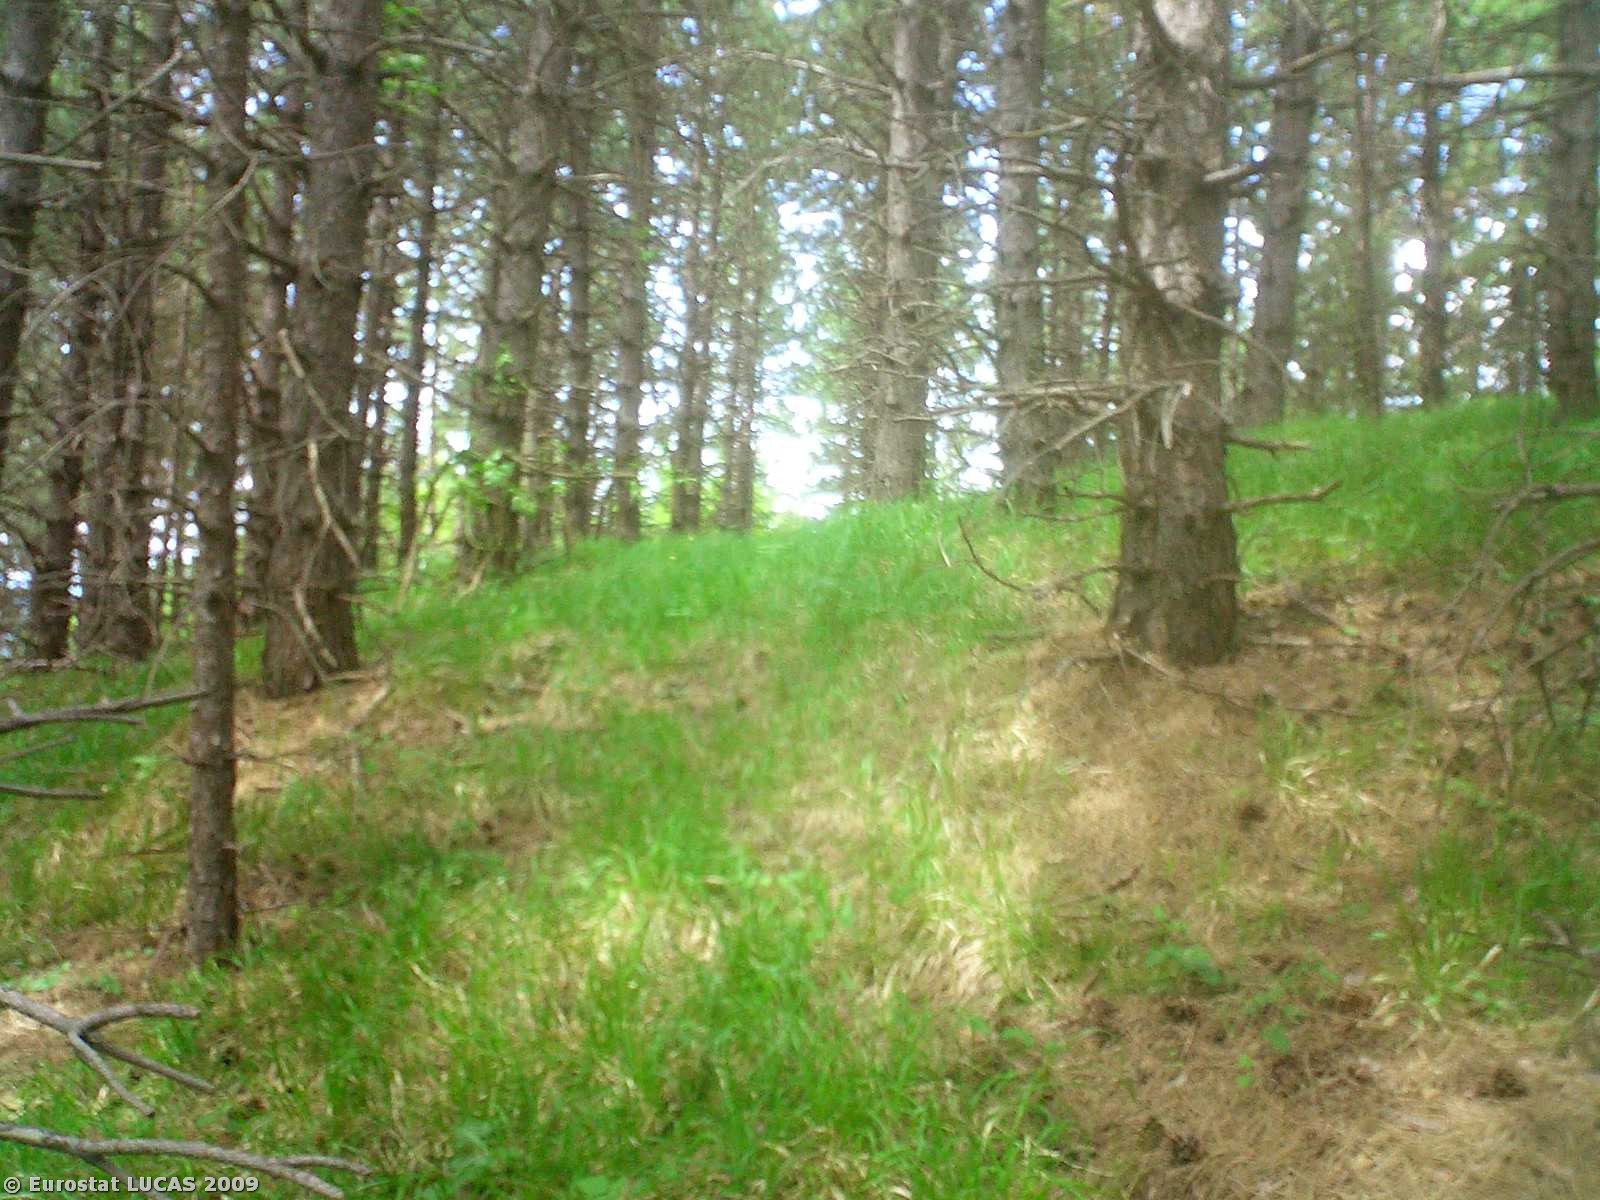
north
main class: Woodland
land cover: Coniferous woodland
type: alpine coniferous forest
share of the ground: 50 - 75 %
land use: Forestry
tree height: > 5 m
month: May
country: IT
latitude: 44.1392
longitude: 11.6337
